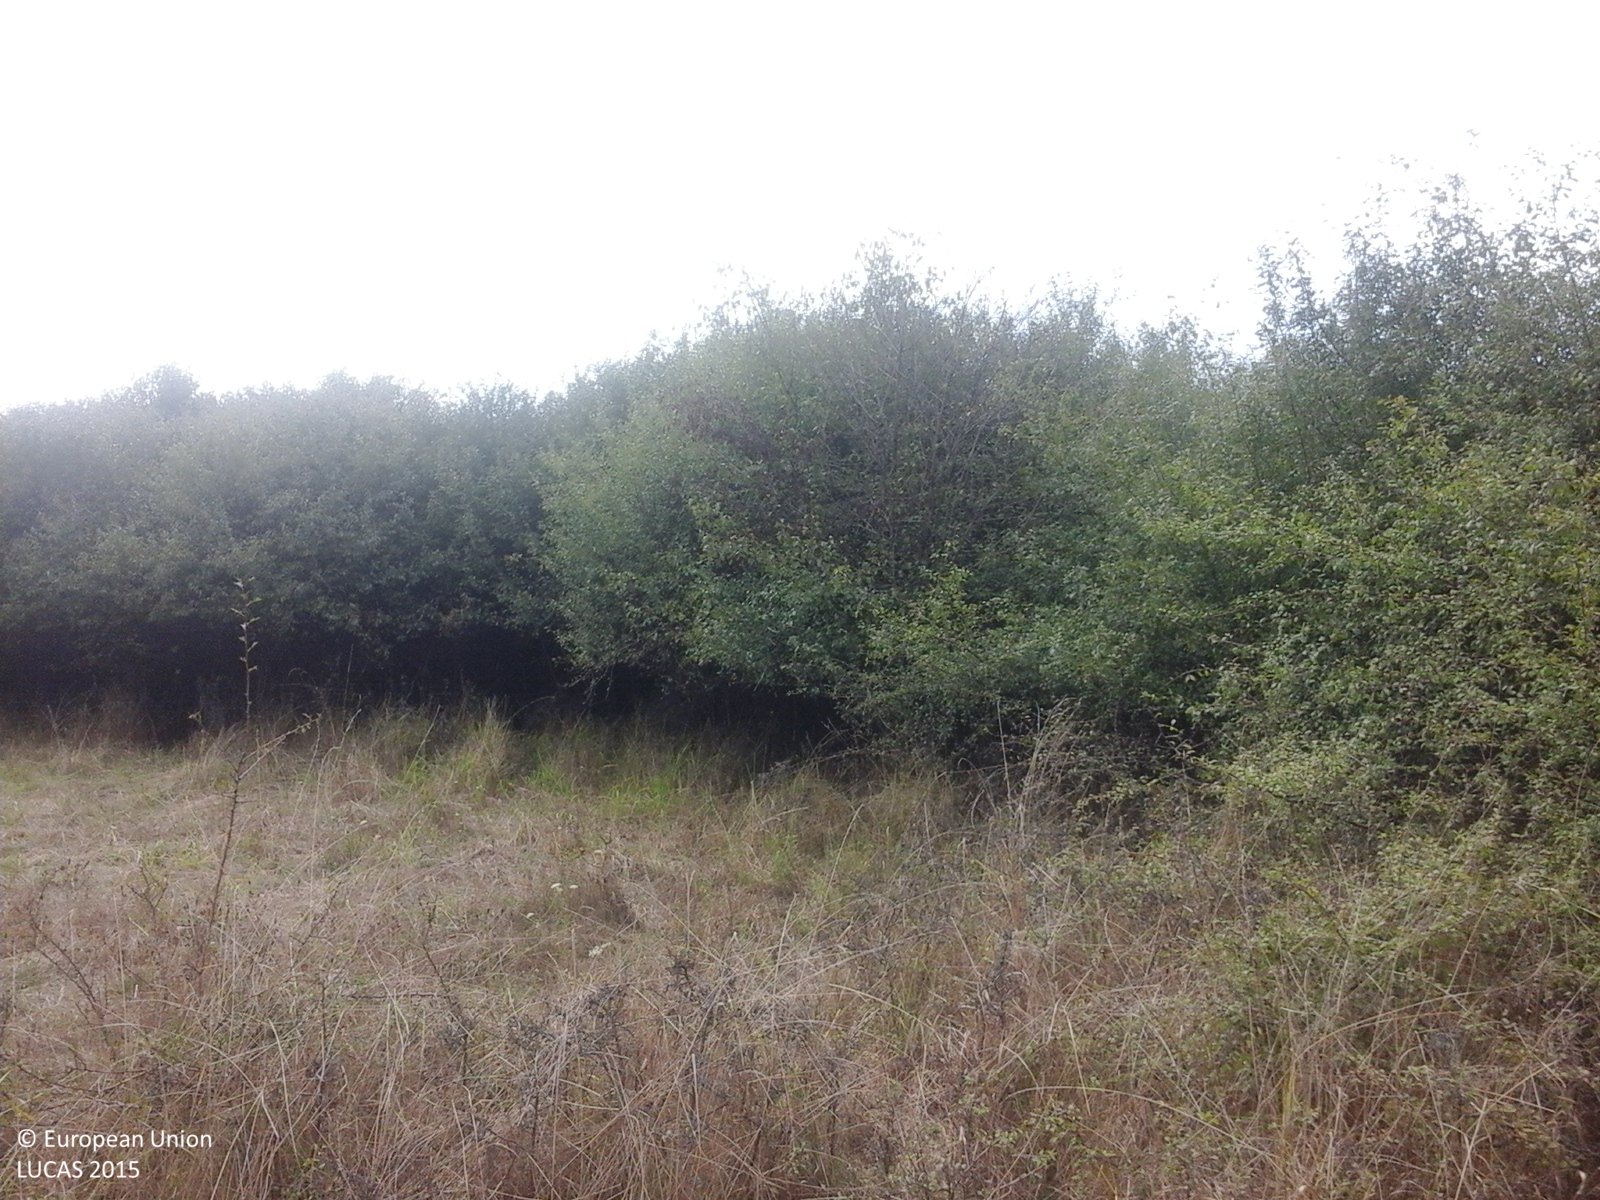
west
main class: Grassland
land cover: Grassland with sparse tree/shrub cover
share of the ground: > 75 %
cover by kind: herbaceous plants 85 %, shrubs 10 %, broadleaved forest trees 5 %
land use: Agriculture (excluding fallow land and kitchen gardens)
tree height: < 5 m
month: August
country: RO
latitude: 45.4215
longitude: 21.3143
